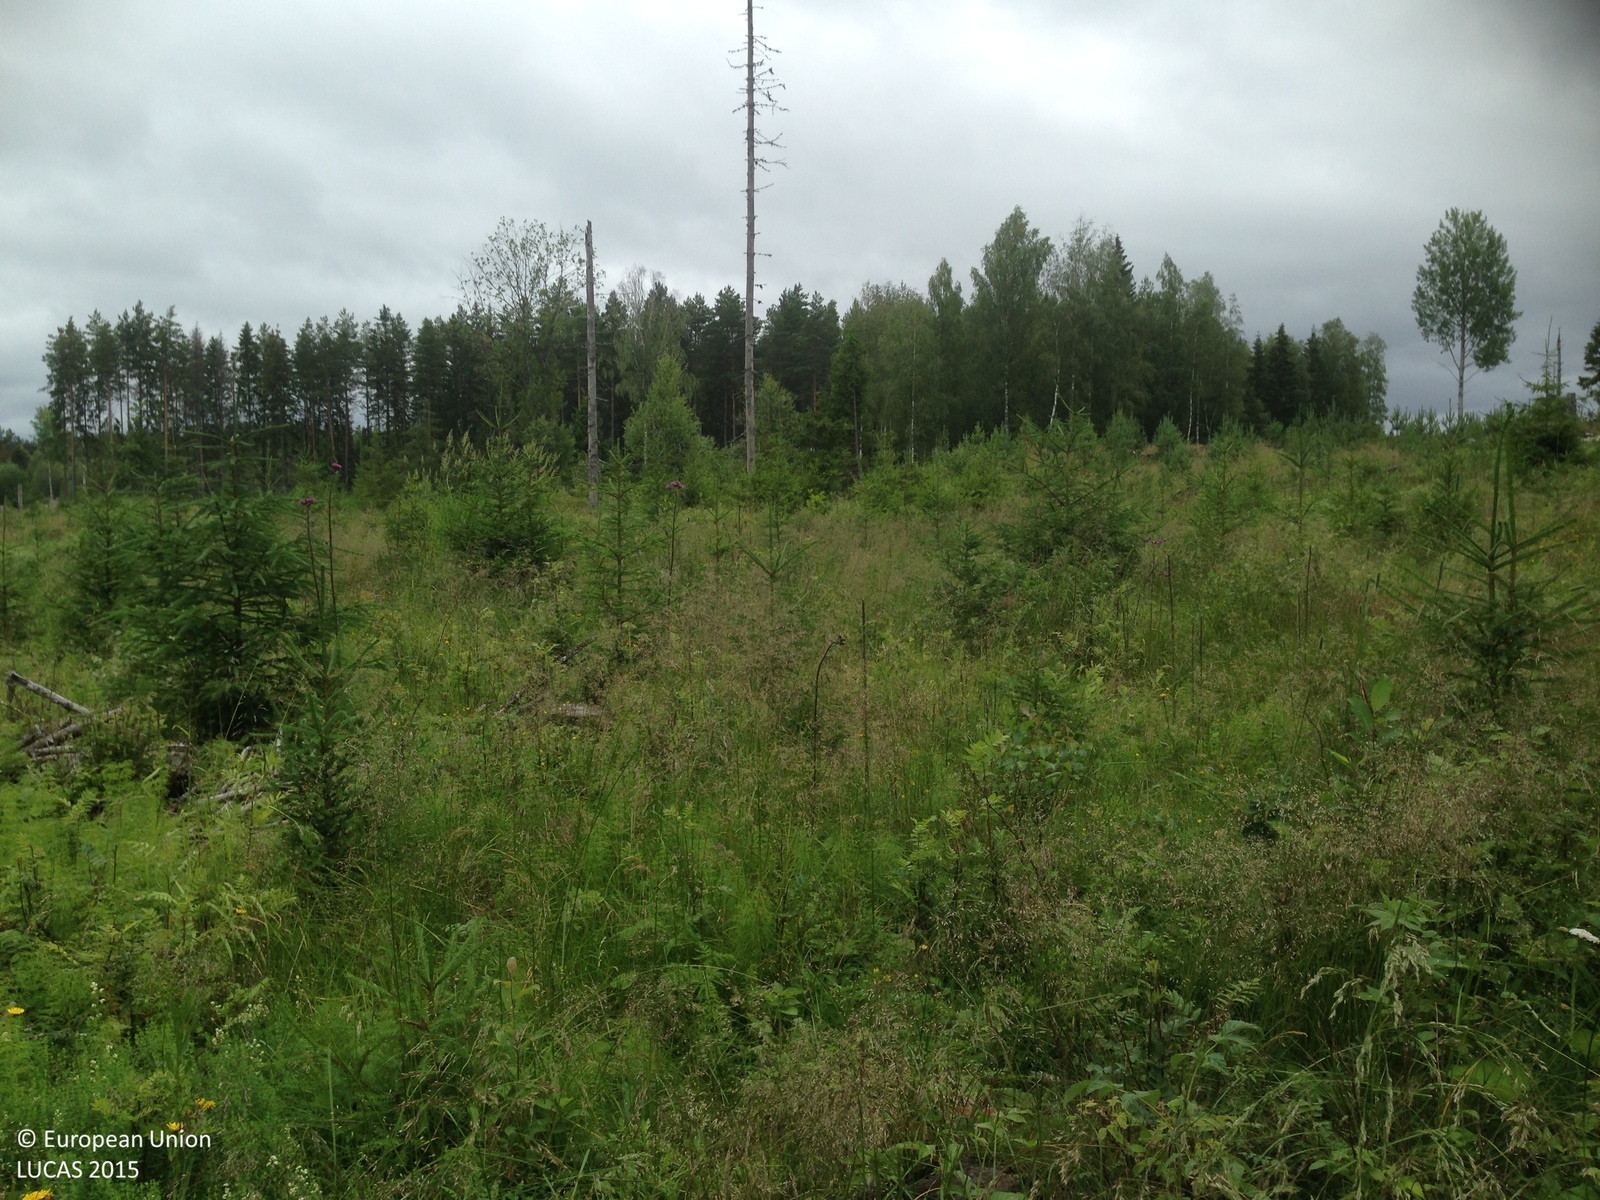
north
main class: Woodland
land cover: Spruce dominated coniferous woodland
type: boreal forest
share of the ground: 25 - 50 %
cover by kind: coniferous forest trees 40 %, herbaceous plants 25 %, lichens and mosses 25 %, broadleaved forest trees 10 %
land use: Forestry
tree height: < 5 m
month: July
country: SE
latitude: 59.8814
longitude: 16.9778
